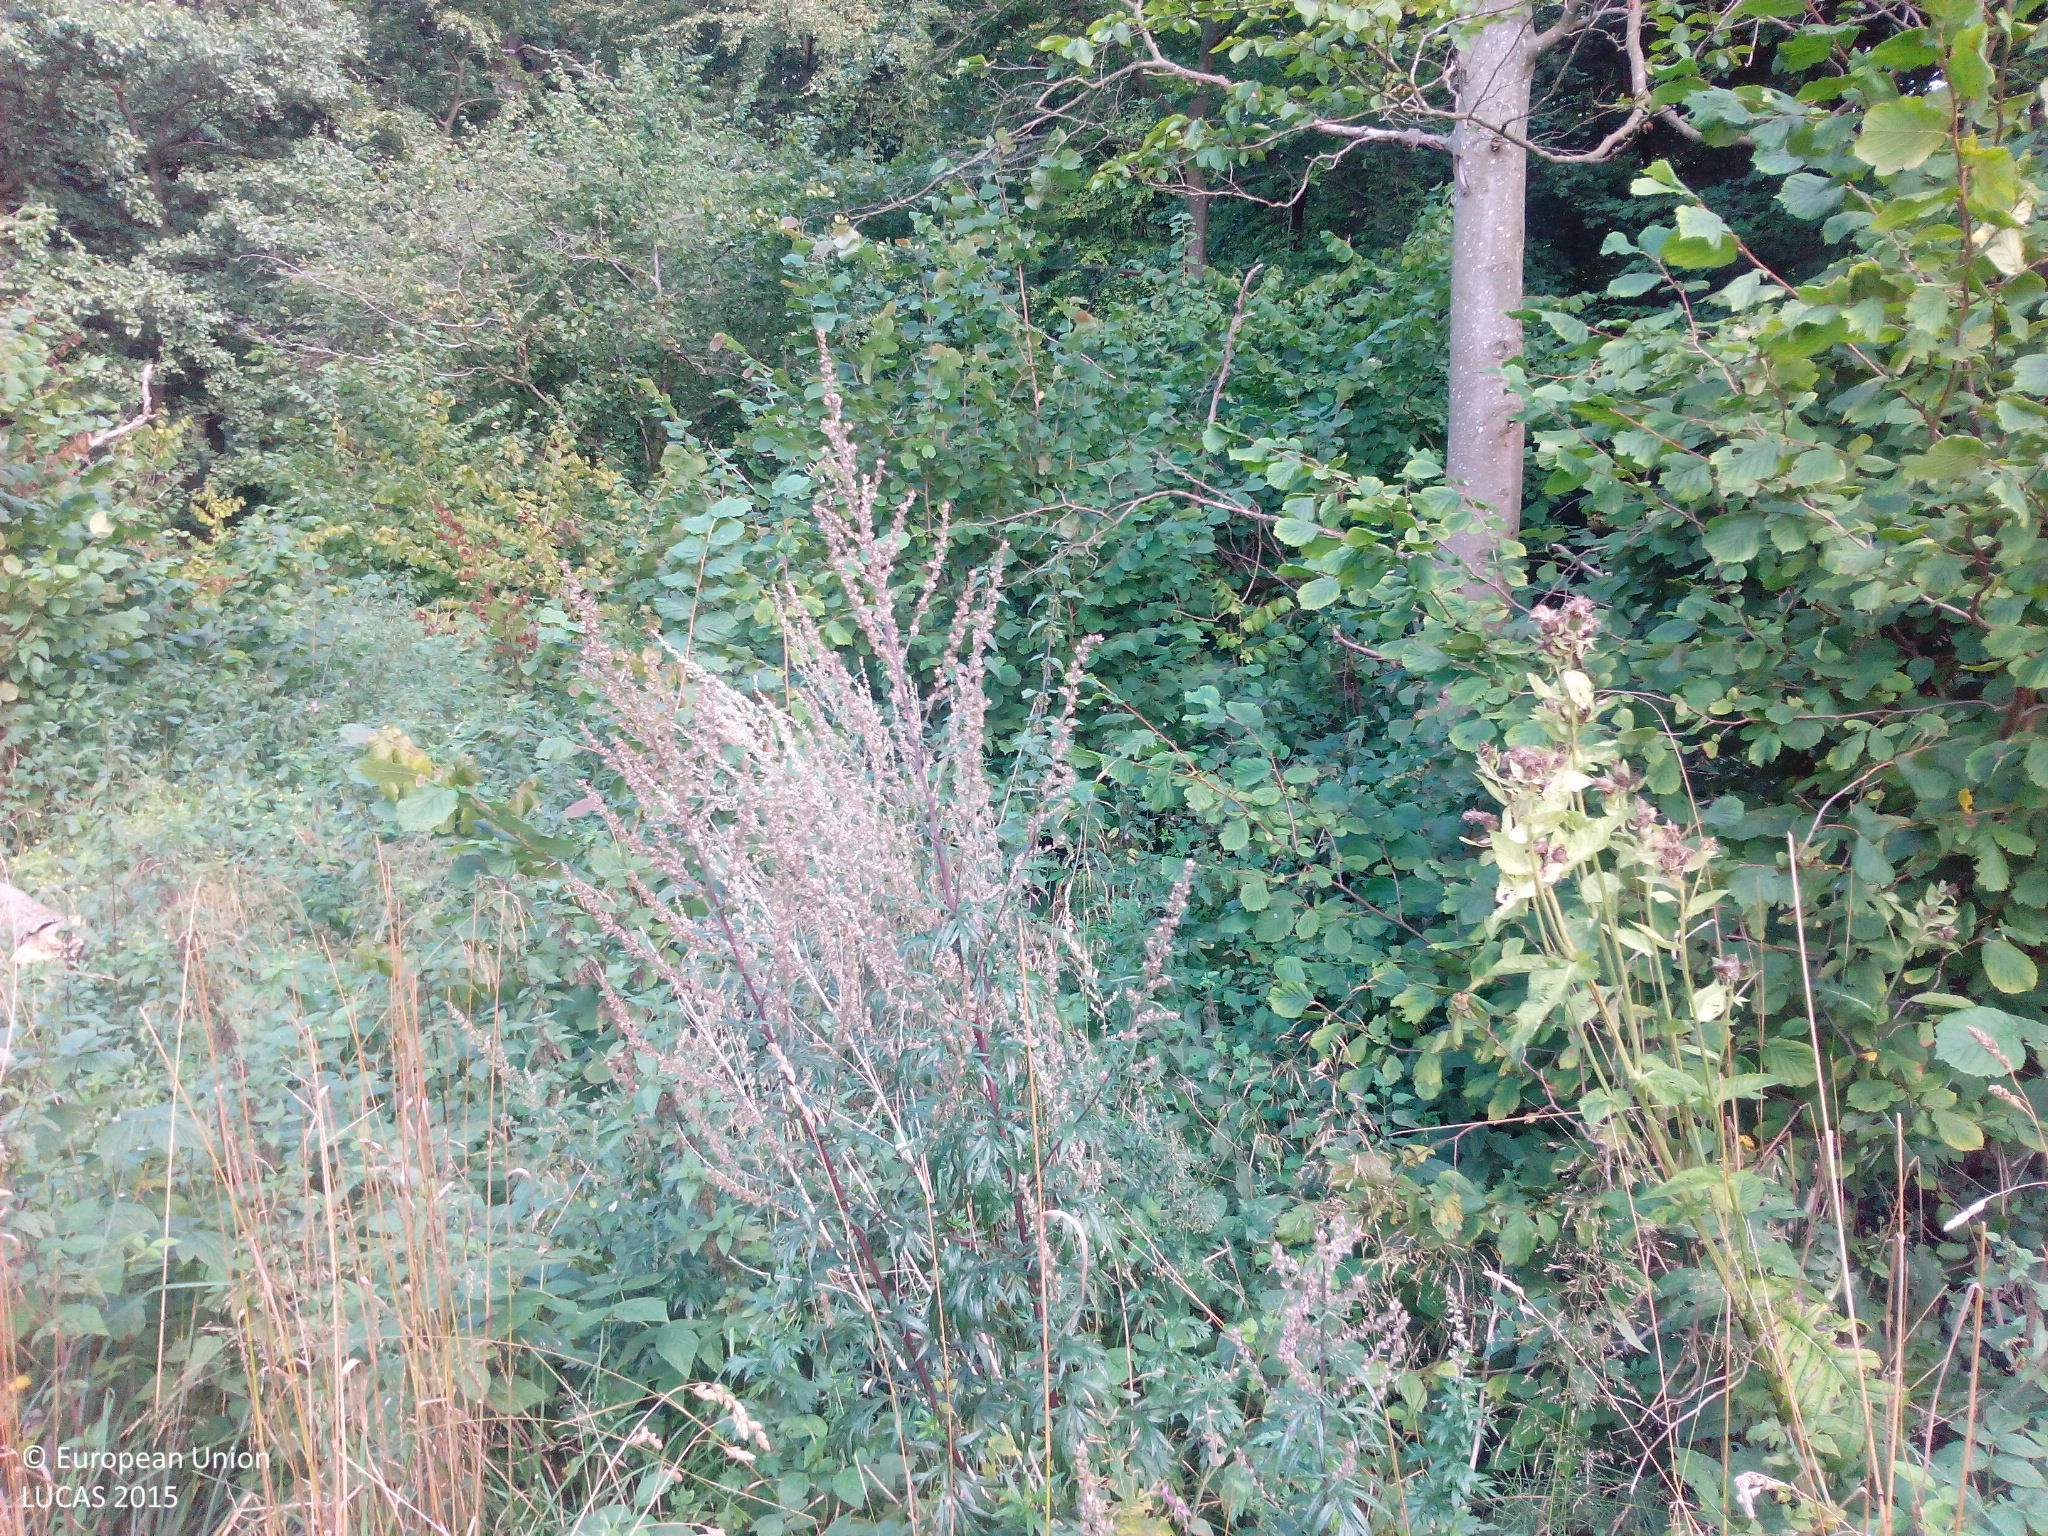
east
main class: Woodland
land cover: Broadleaved woodland
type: mesophytic deciduous forest
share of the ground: 50 - 75 %
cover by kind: broadleaved forest trees 50 %, shrubs 40 %, herbaceous plants 10 %
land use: Forestry
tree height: > 5 m
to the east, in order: Broadleaved woodland; Tracks; Broadleaved woodland; Grassland with sparse tree/shrub cover; Broadleaved woodland
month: August
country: DE
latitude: 54.0751
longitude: 12.6125
